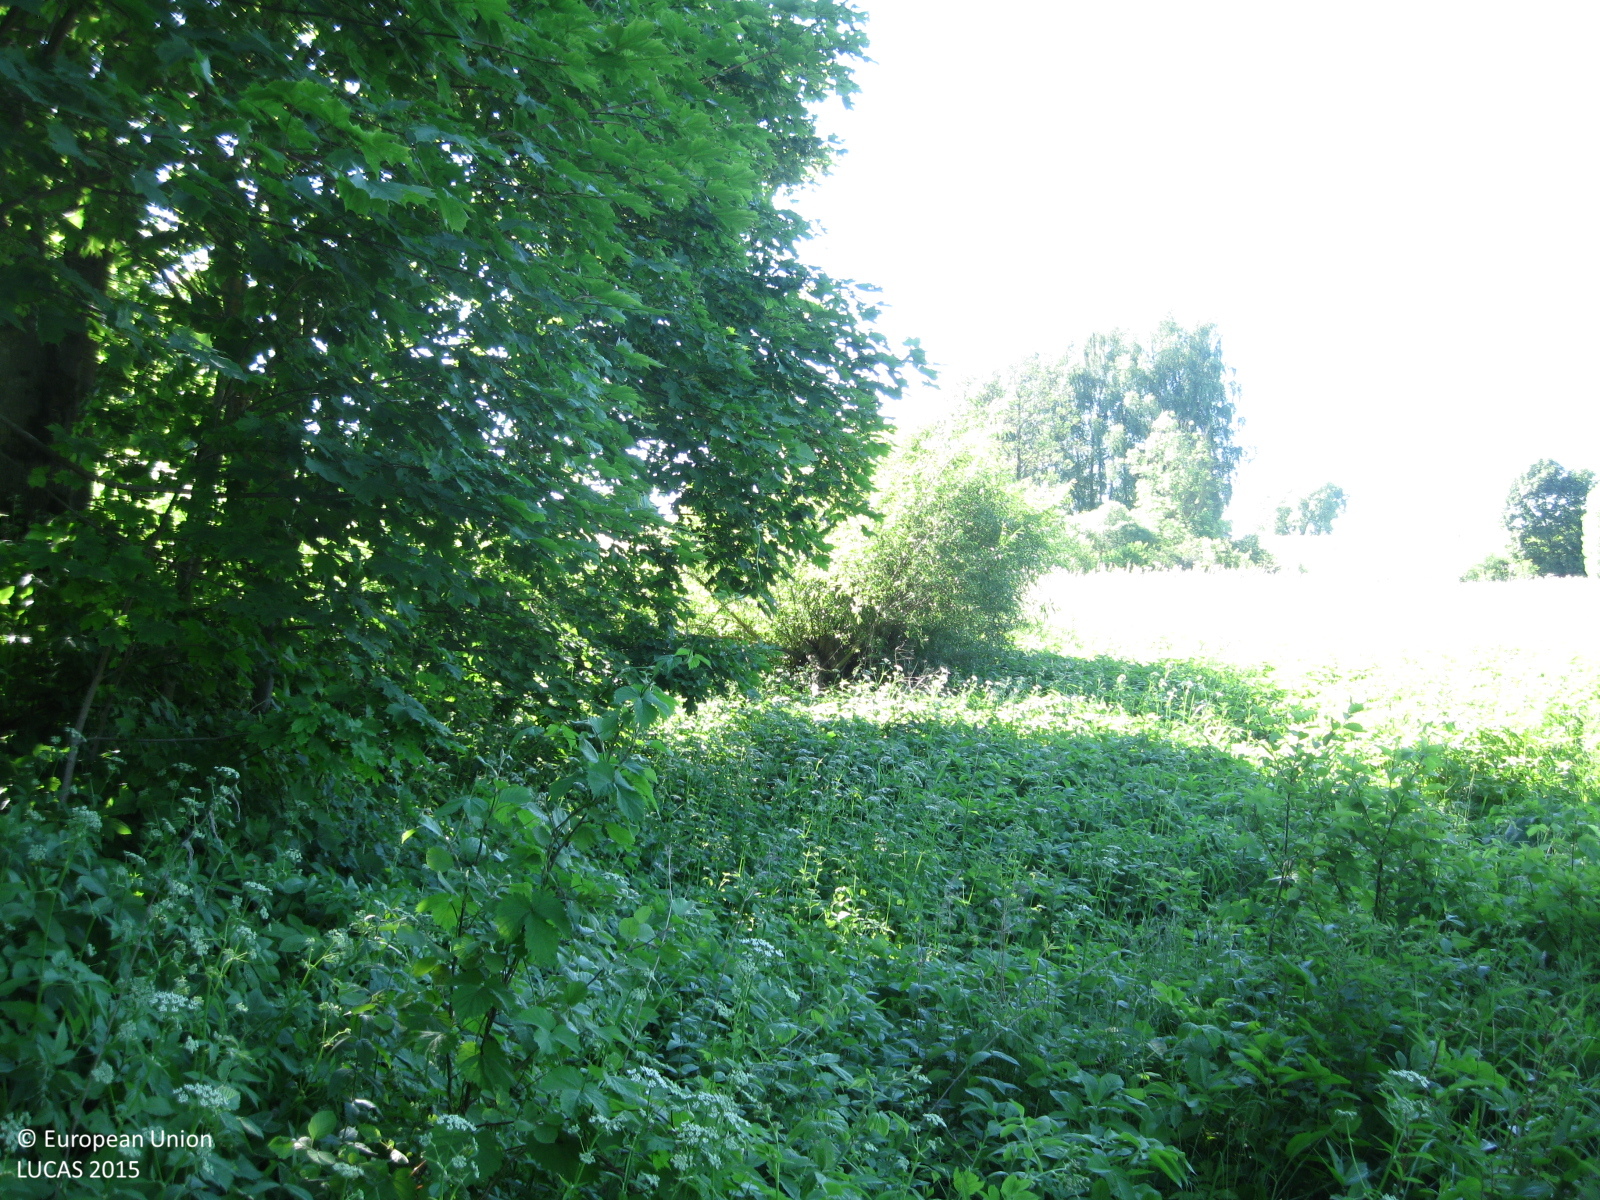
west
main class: Grassland
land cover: Spontaneously vegetated surfaces
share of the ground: > 75 %
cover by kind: herbaceous plants 100 %
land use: Semi-natural and natural areas not in use
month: June
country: LT
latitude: 55.6884
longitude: 24.0071
